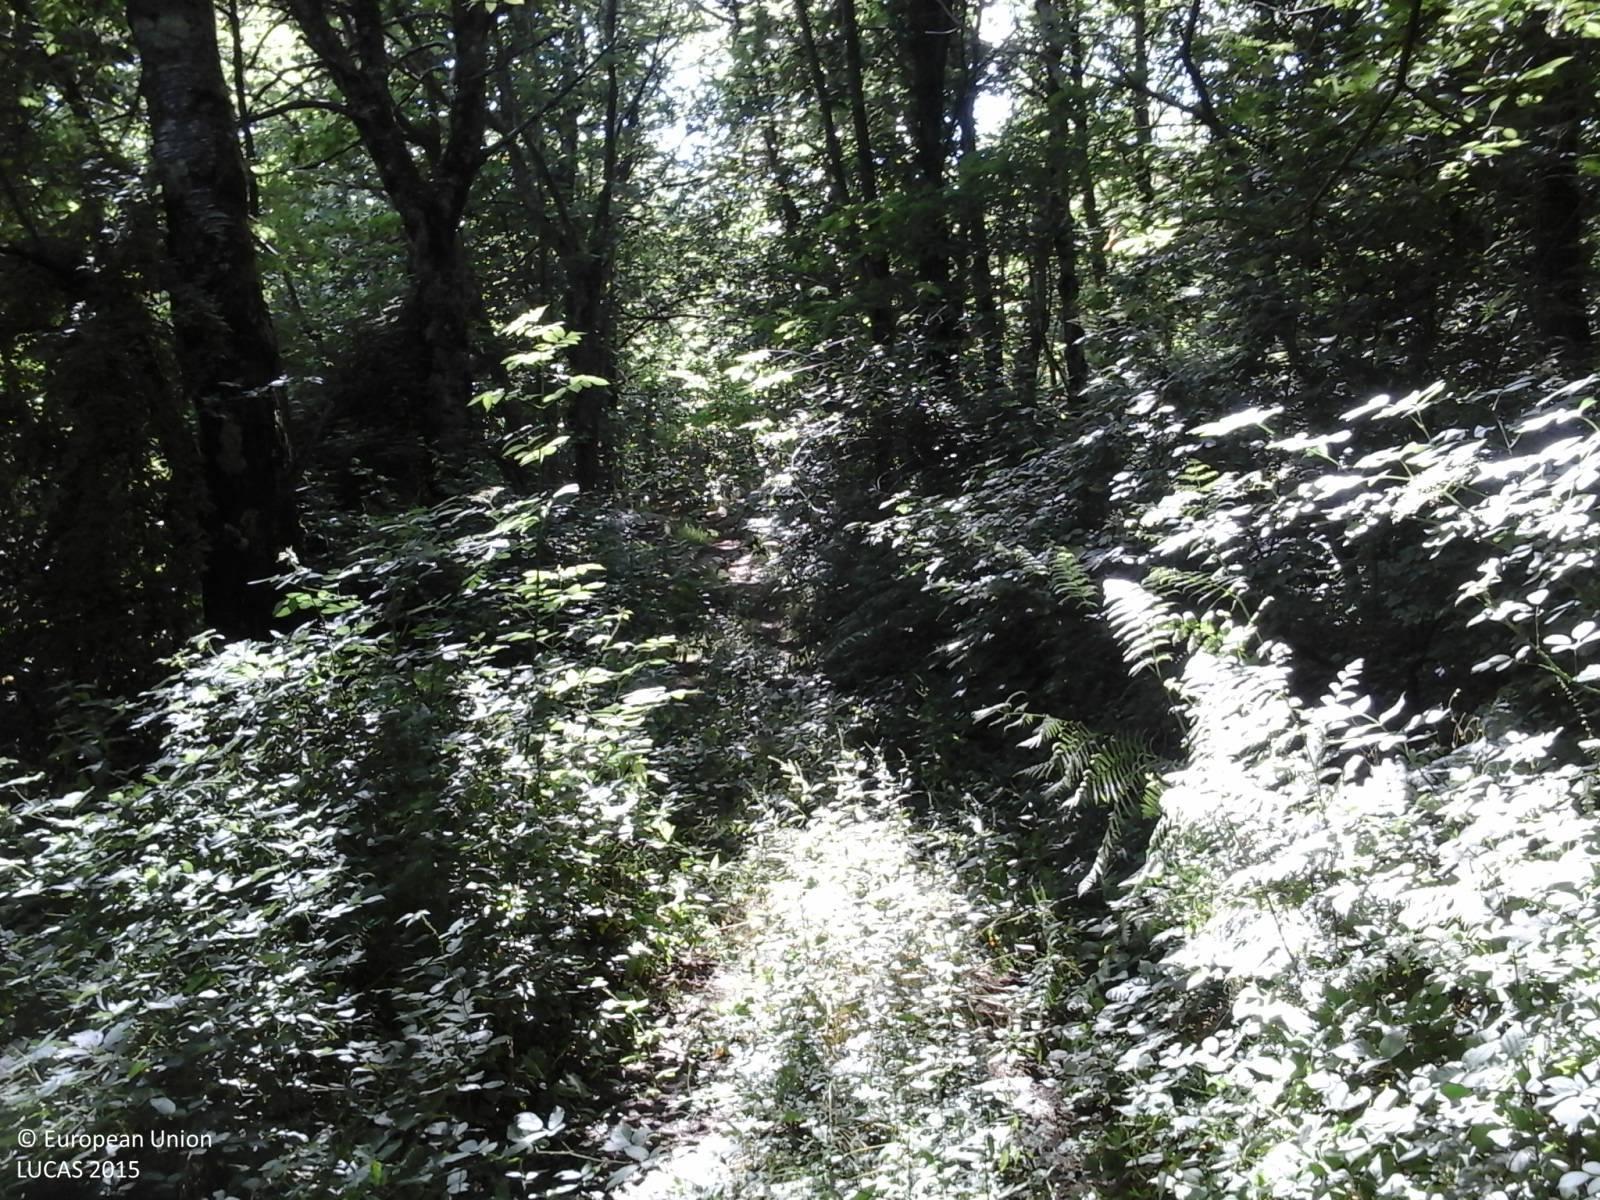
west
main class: Woodland
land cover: Broadleaved woodland
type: thermophilous deciduous forest
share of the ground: > 75 %
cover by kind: broadleaved forest trees 100 %
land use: Forestry
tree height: > 5 m
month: June
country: IT
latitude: 44.1699
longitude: 10.2370
